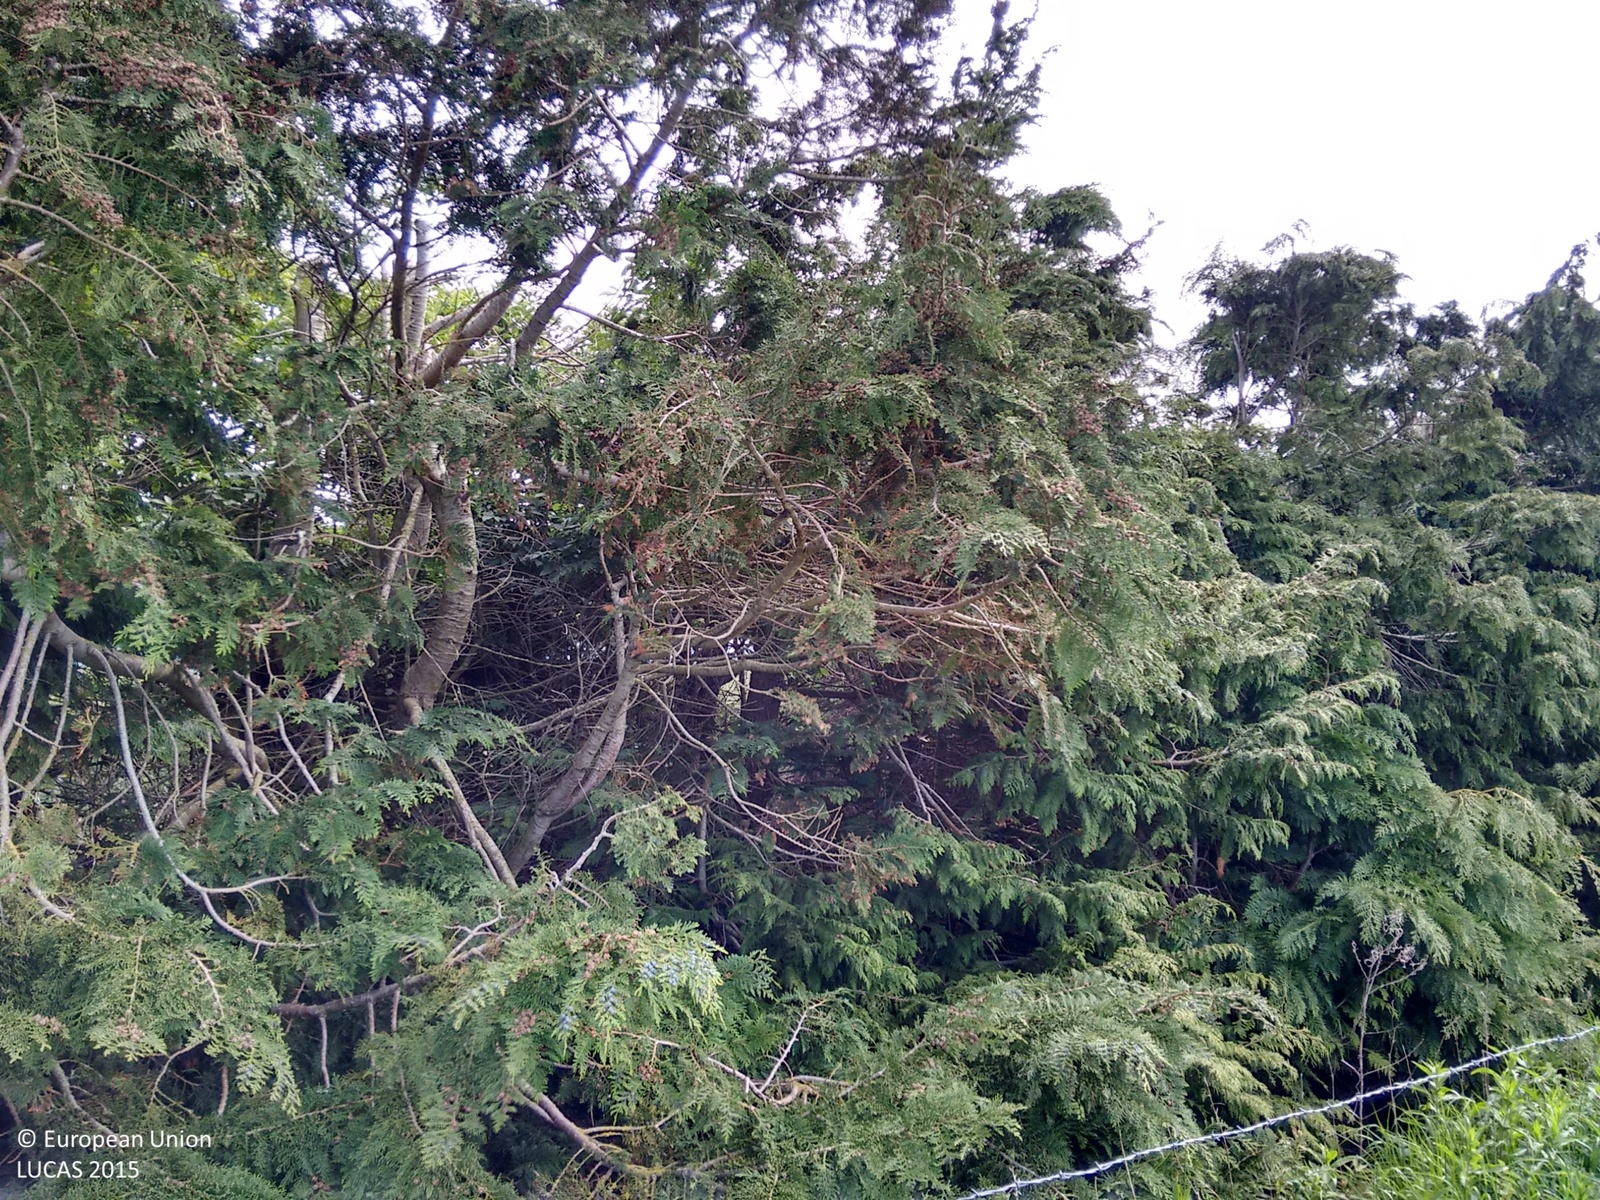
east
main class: Grassland
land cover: Grassland without tree/shrub cover
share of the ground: > 75 %
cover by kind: herbaceous plants 60 %, shrubs 5 %
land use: Agriculture (excluding fallow land and kitchen gardens)
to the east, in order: Grassland without tree/shrub cover; Artificial constructions in urban areas
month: June
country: IE
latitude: 53.2312
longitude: -6.9027
